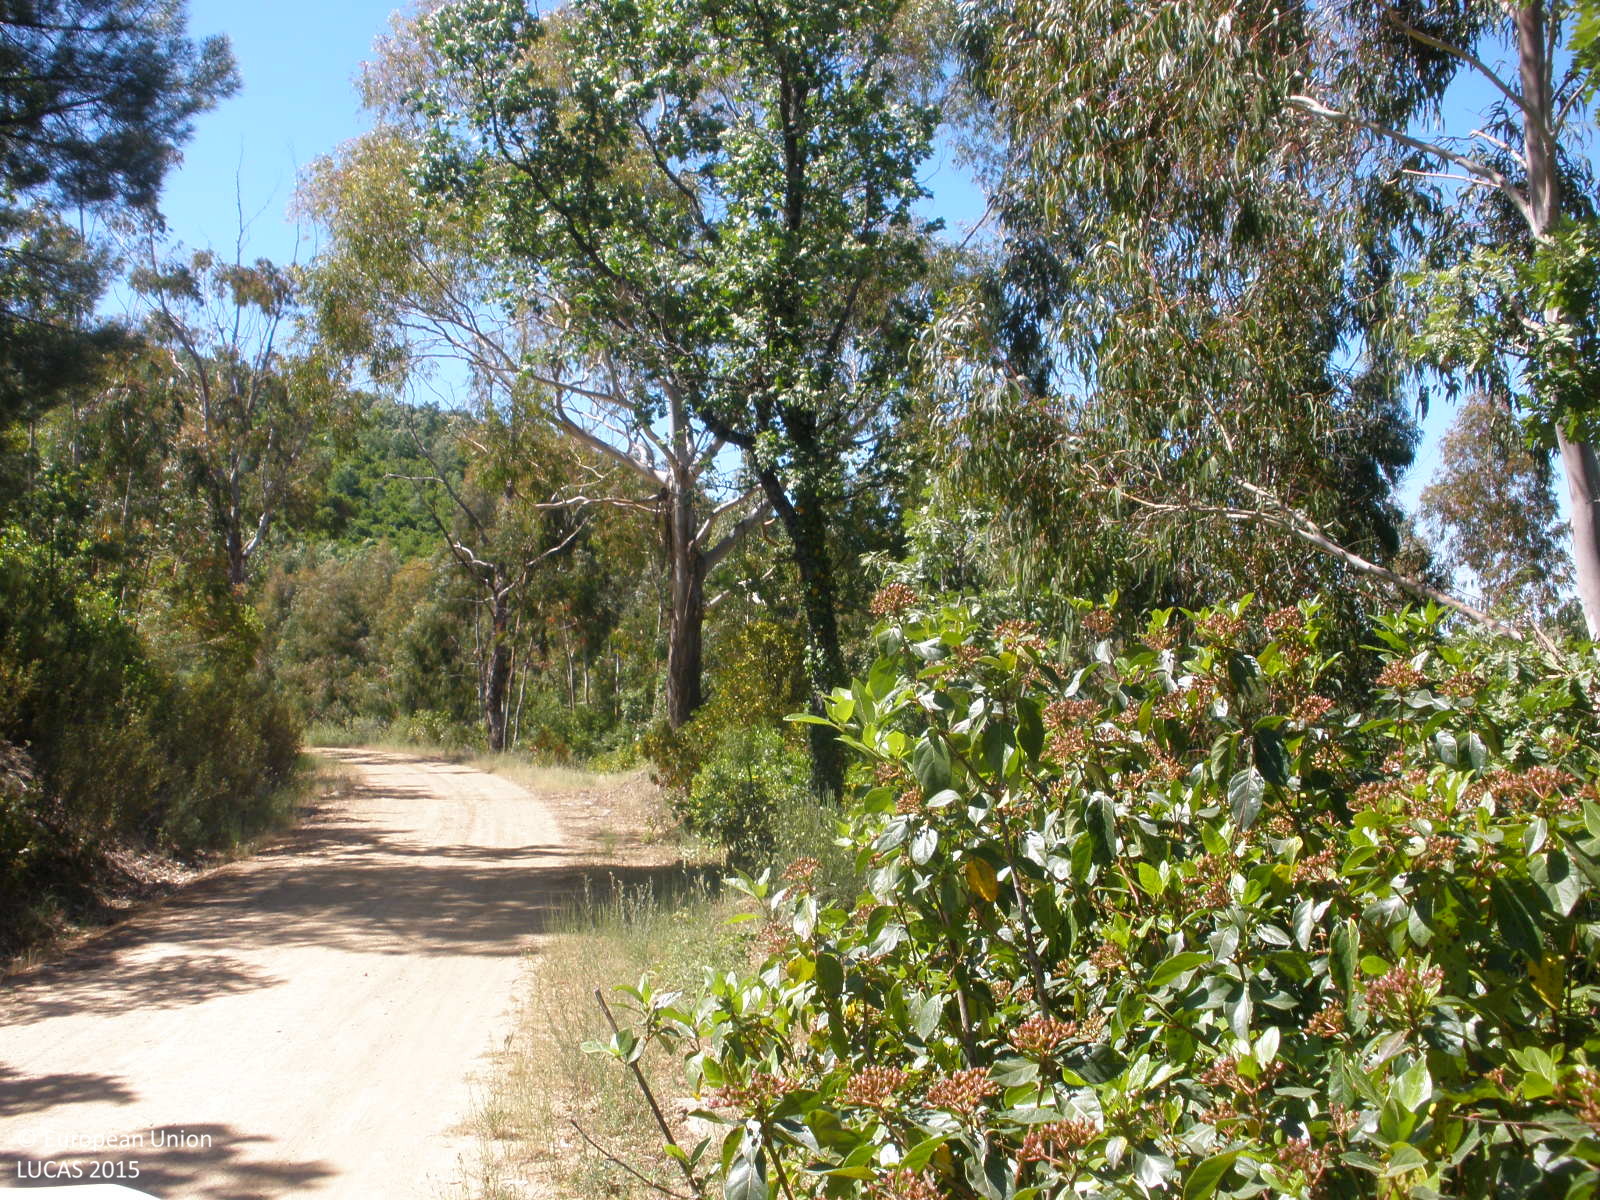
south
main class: Woodland
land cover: Broadleaved woodland
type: broadleaved evergreen forest
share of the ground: > 75 %
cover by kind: broadleaved forest trees 70 %, shrubs 30 %
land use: Forestry
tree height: > 5 m
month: May
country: ES
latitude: 40.4812
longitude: -5.9418
